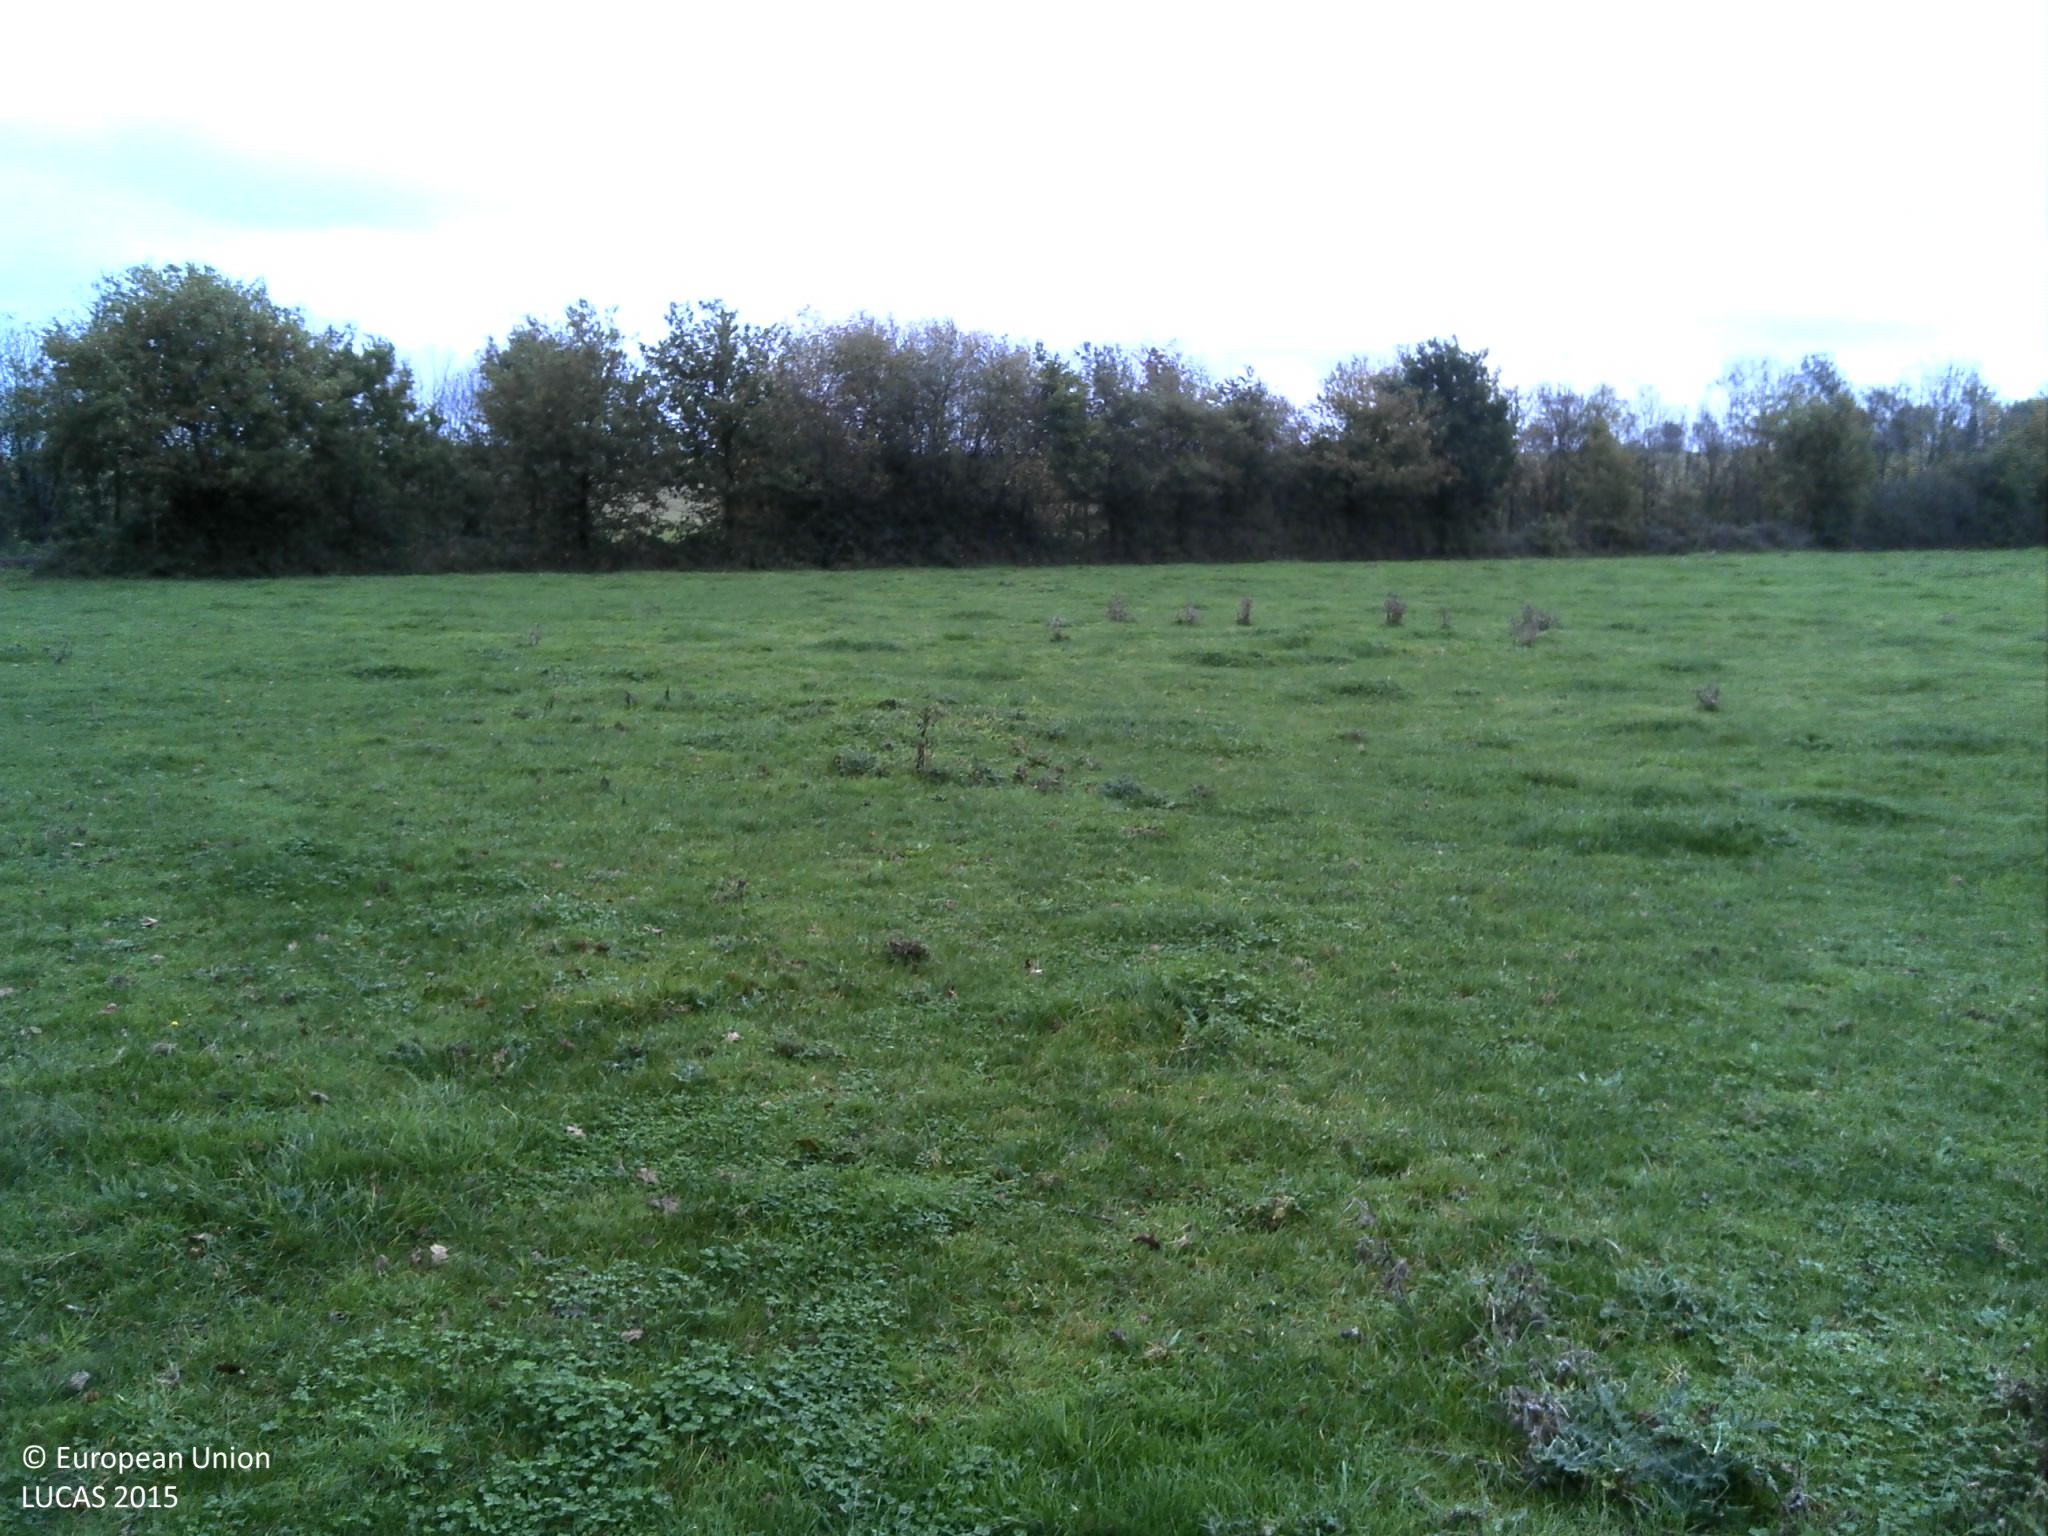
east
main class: Grassland
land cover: Grassland without tree/shrub cover
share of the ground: > 75 %
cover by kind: herbaceous plants 100 %
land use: Agriculture (excluding fallow land and kitchen gardens)
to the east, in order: Grassland without tree/shrub cover; Fences; Groves; Ditches and canals; Tracks; Ditches and canals; Lines of trees; Temporary grasslands
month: November
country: FR
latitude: 47.6362
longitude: -1.3412
